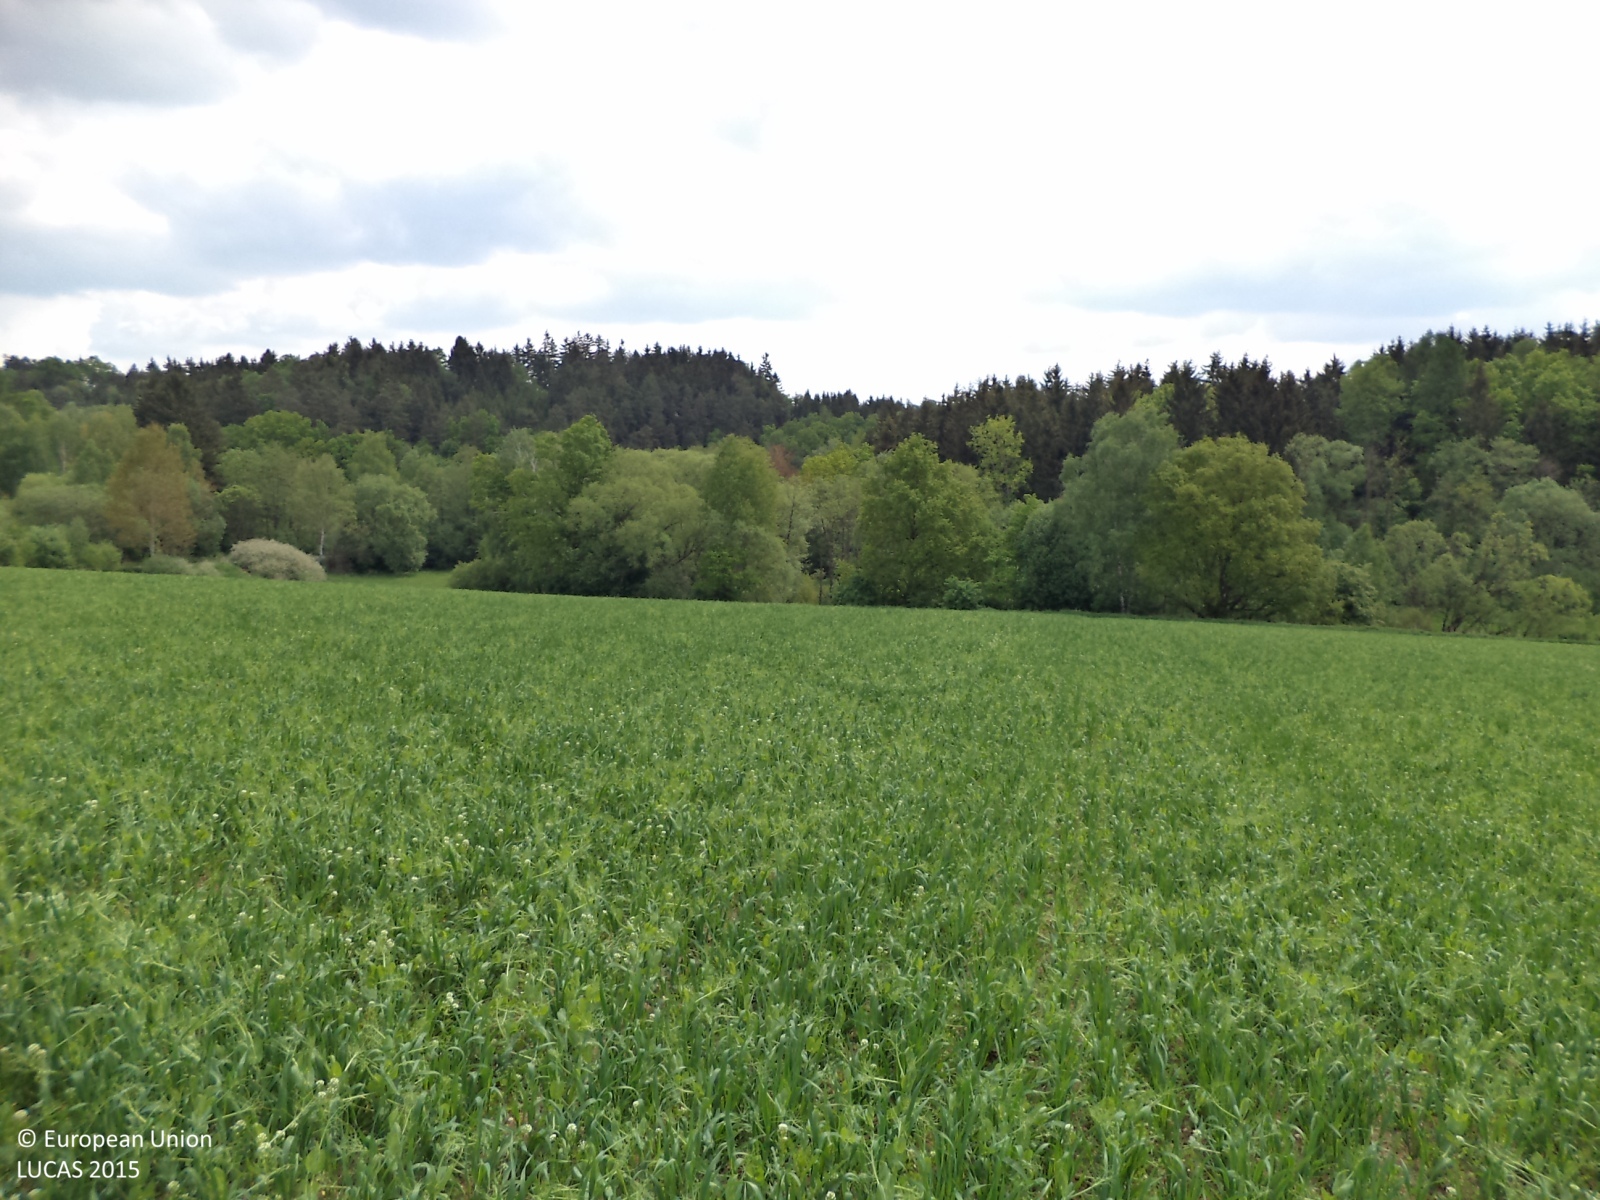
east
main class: Cropland
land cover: Mixed cereals for fodder
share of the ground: > 75 %
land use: Agriculture (excluding fallow land and kitchen gardens)
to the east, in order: Mixed cereals for fodder; Grass margins; Tracks; Broadleaved woodland; Grassland without tree/shrub cover; Broadleaved woodland
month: May
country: CZ
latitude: 49.5833
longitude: 15.1066
